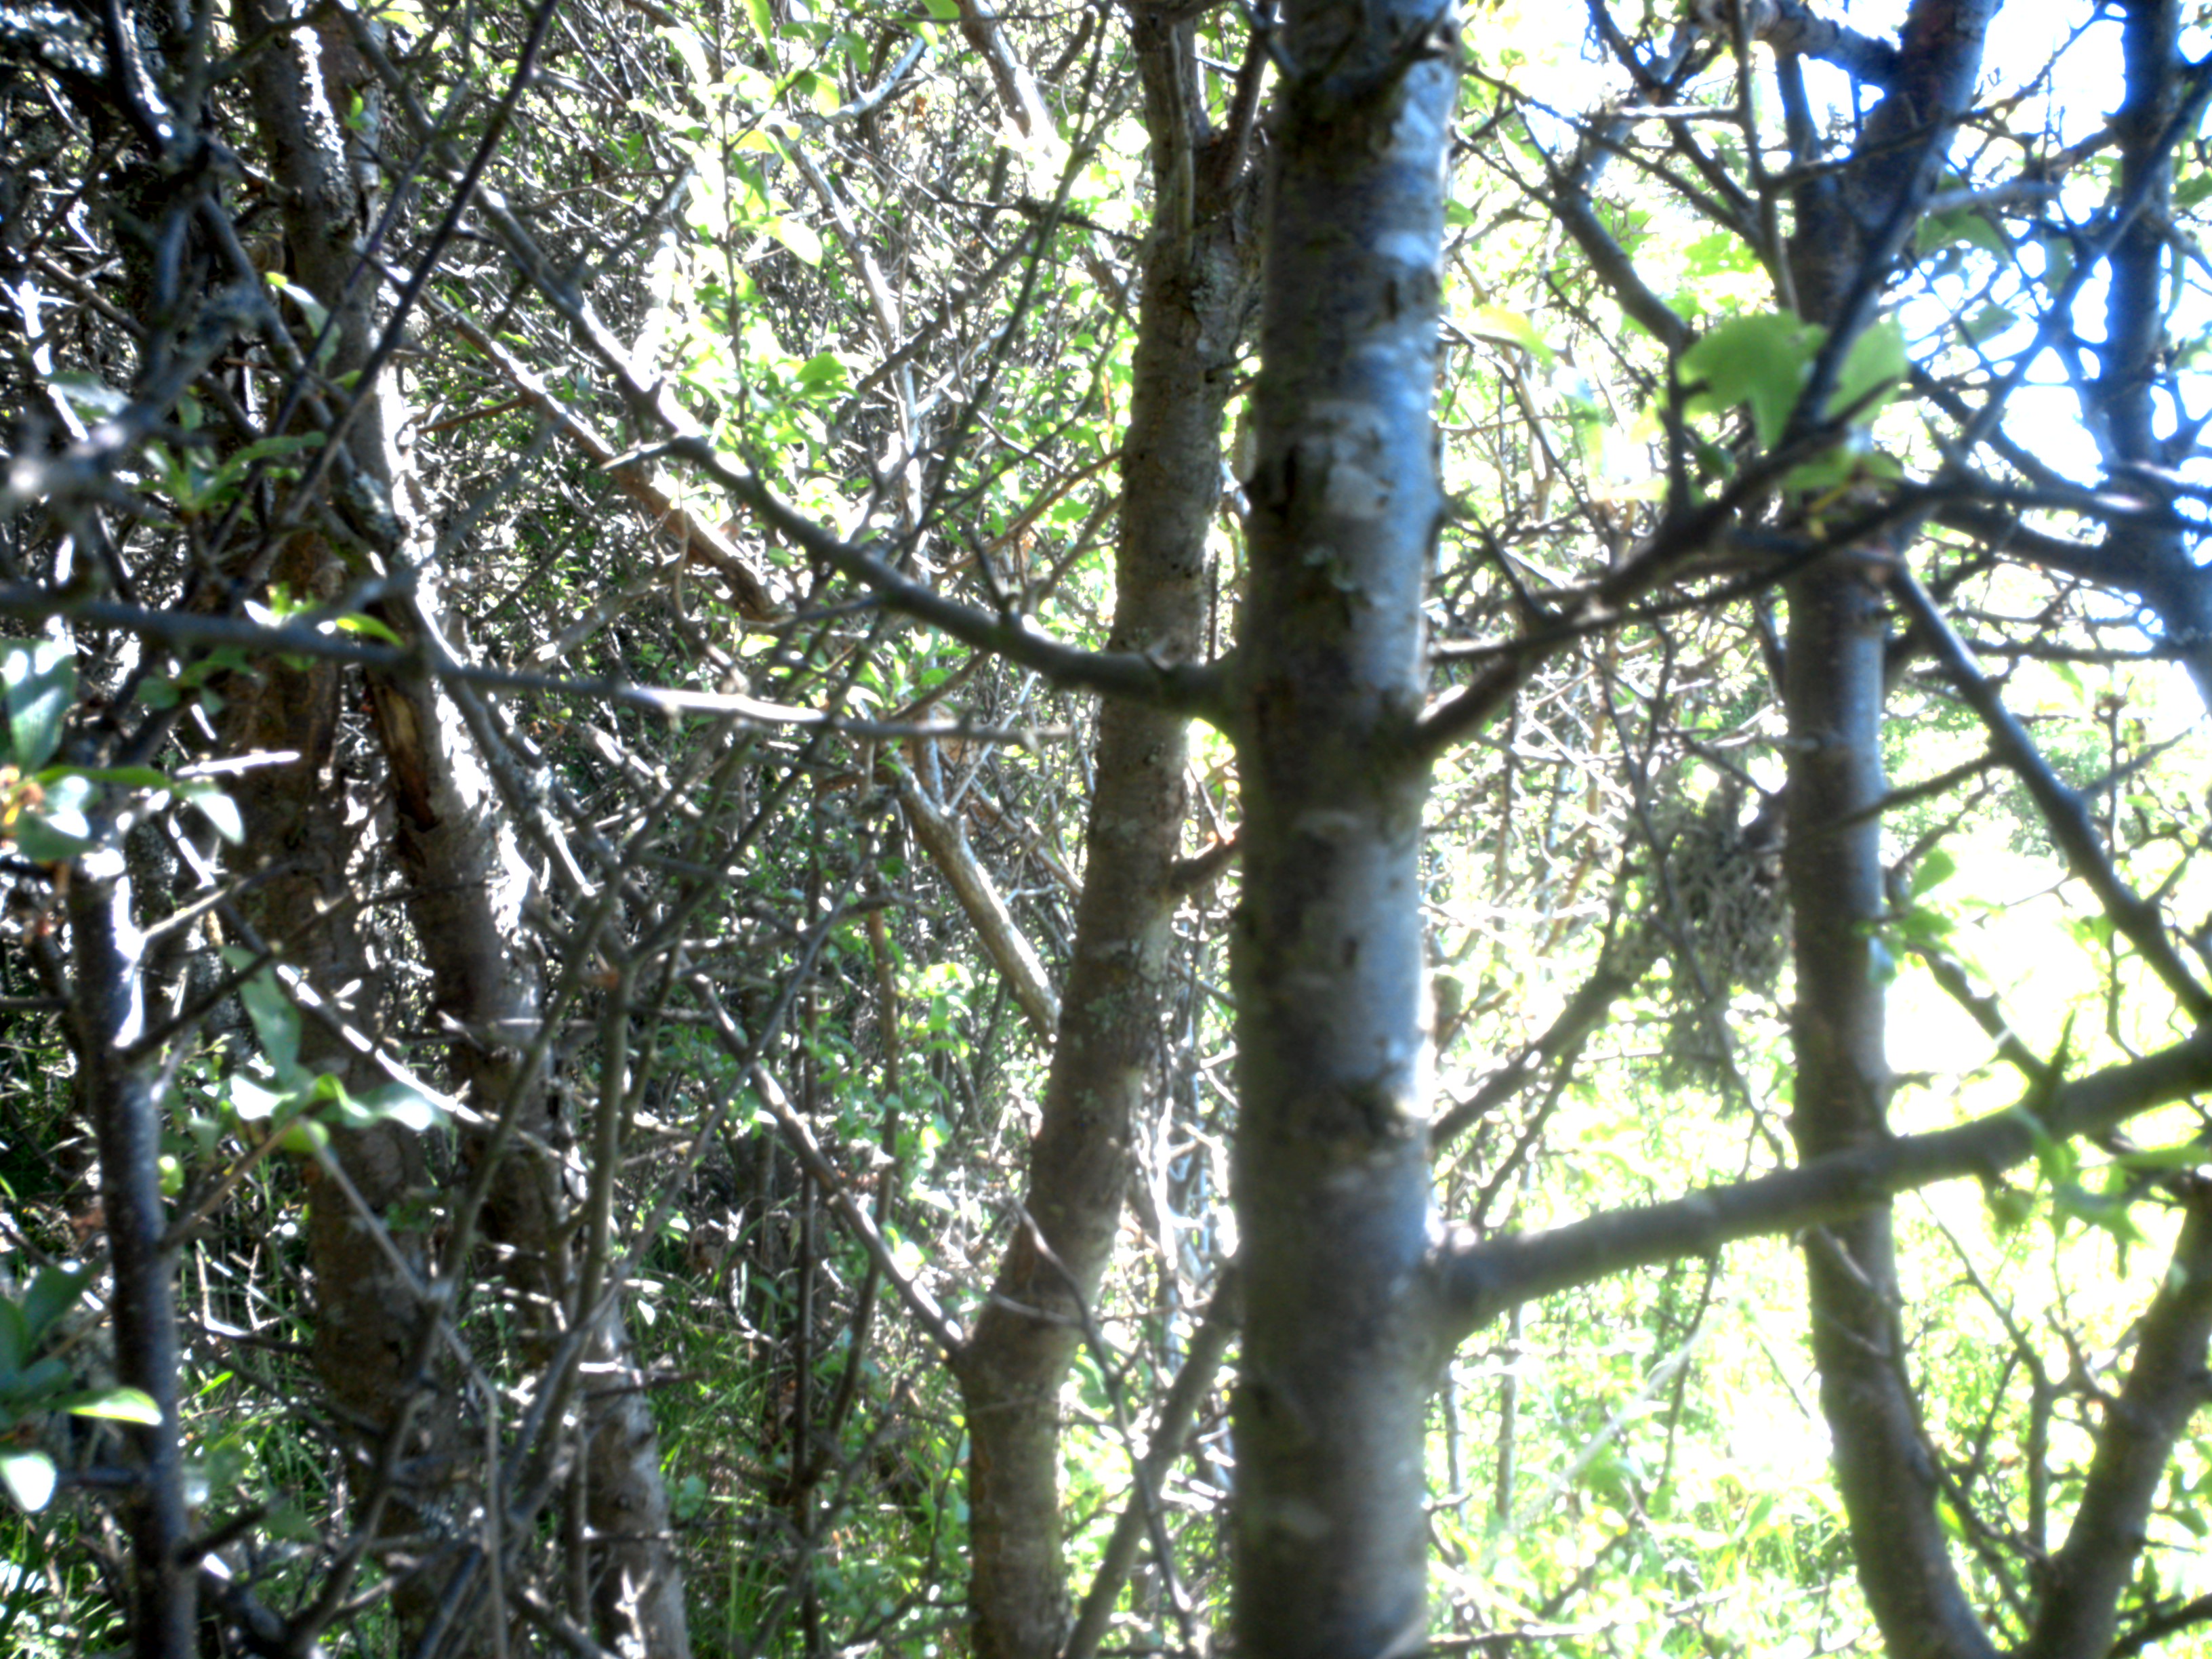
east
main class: Shrubland
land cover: Shrubland with sparse tree cover
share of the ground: > 75 %
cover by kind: shrubs 90 %, broadleaved forest trees 5 %, herbaceous plants 5 %
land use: Semi-natural and natural areas not in use
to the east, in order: Shrubland with sparse tree cover; Ditches and canals; Grass margins; Paved roads, cycling and walking lanes; Grass margins; Ditches and canals; Broadleaved woodland; Artificial constructions in urban areas
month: June
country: SE
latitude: 59.2844
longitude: 17.6675
